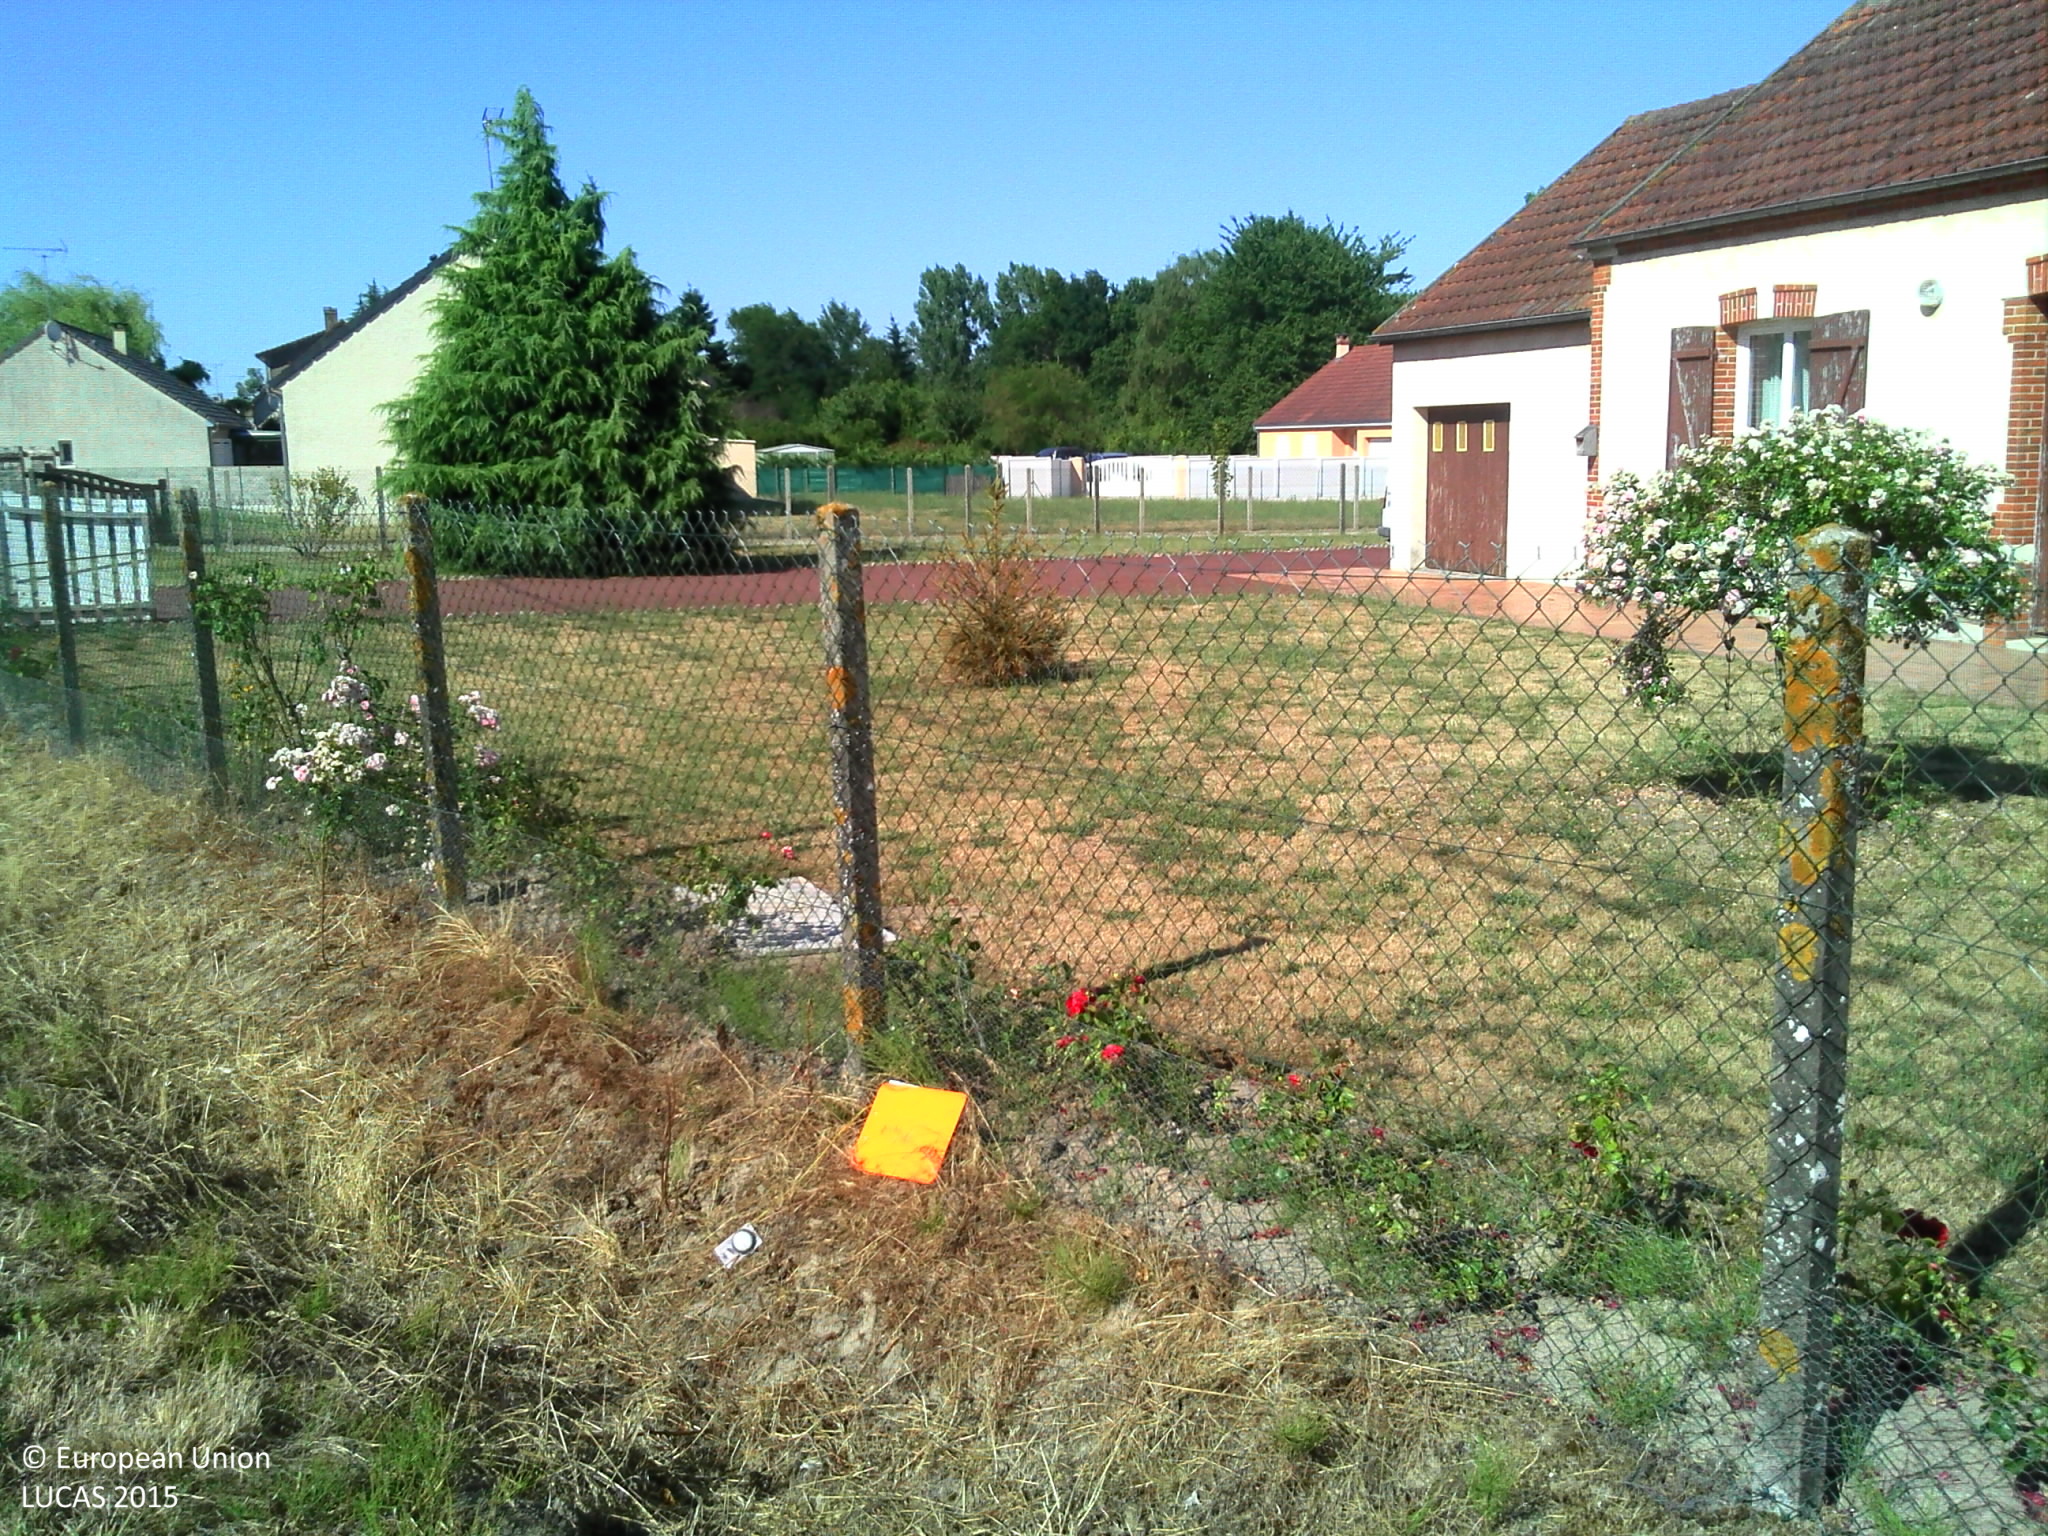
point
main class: Grassland
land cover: Grassland with sparse tree/shrub cover
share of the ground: > 75 %
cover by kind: herbaceous plants 95 %, coniferous forest trees 5 %
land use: Residential
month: July
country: FR
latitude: 47.8965
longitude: 2.5137
